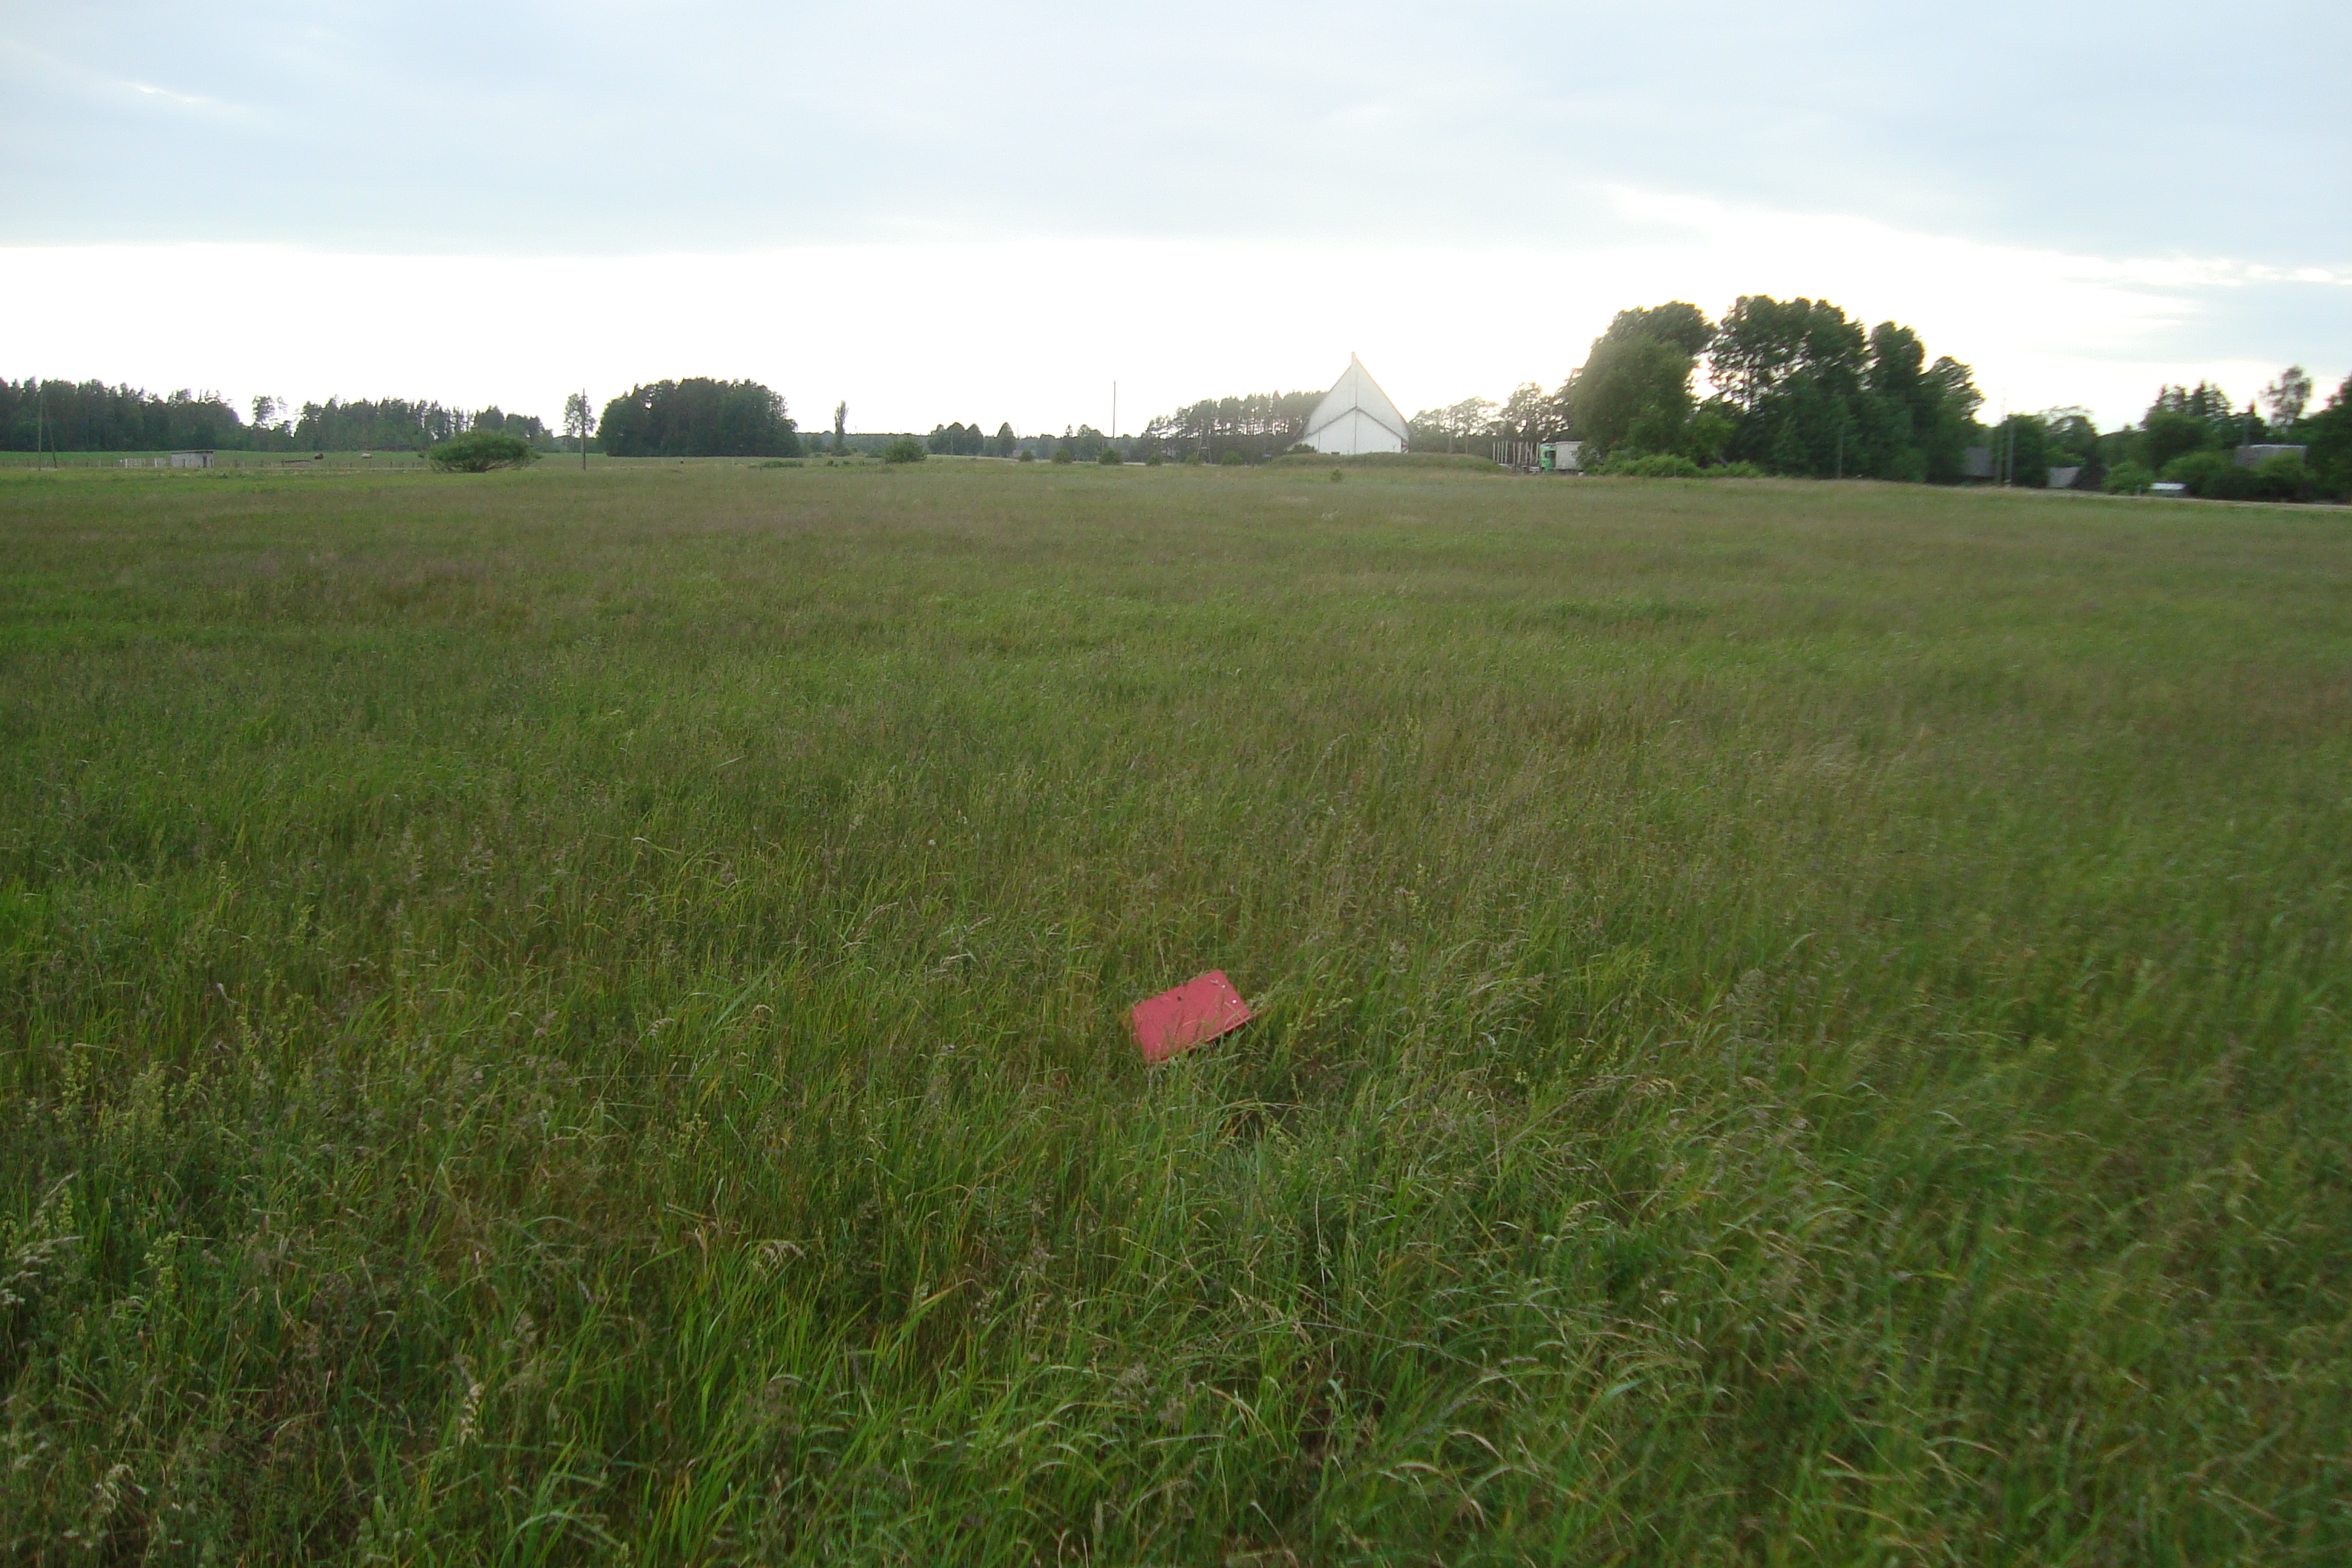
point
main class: Grassland
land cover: Grassland without tree/shrub cover
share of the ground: > 75 %
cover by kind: herbaceous plants 100 %
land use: Agriculture (excluding fallow land and kitchen gardens)
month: June
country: LV
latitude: 57.2387
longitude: 26.3952
